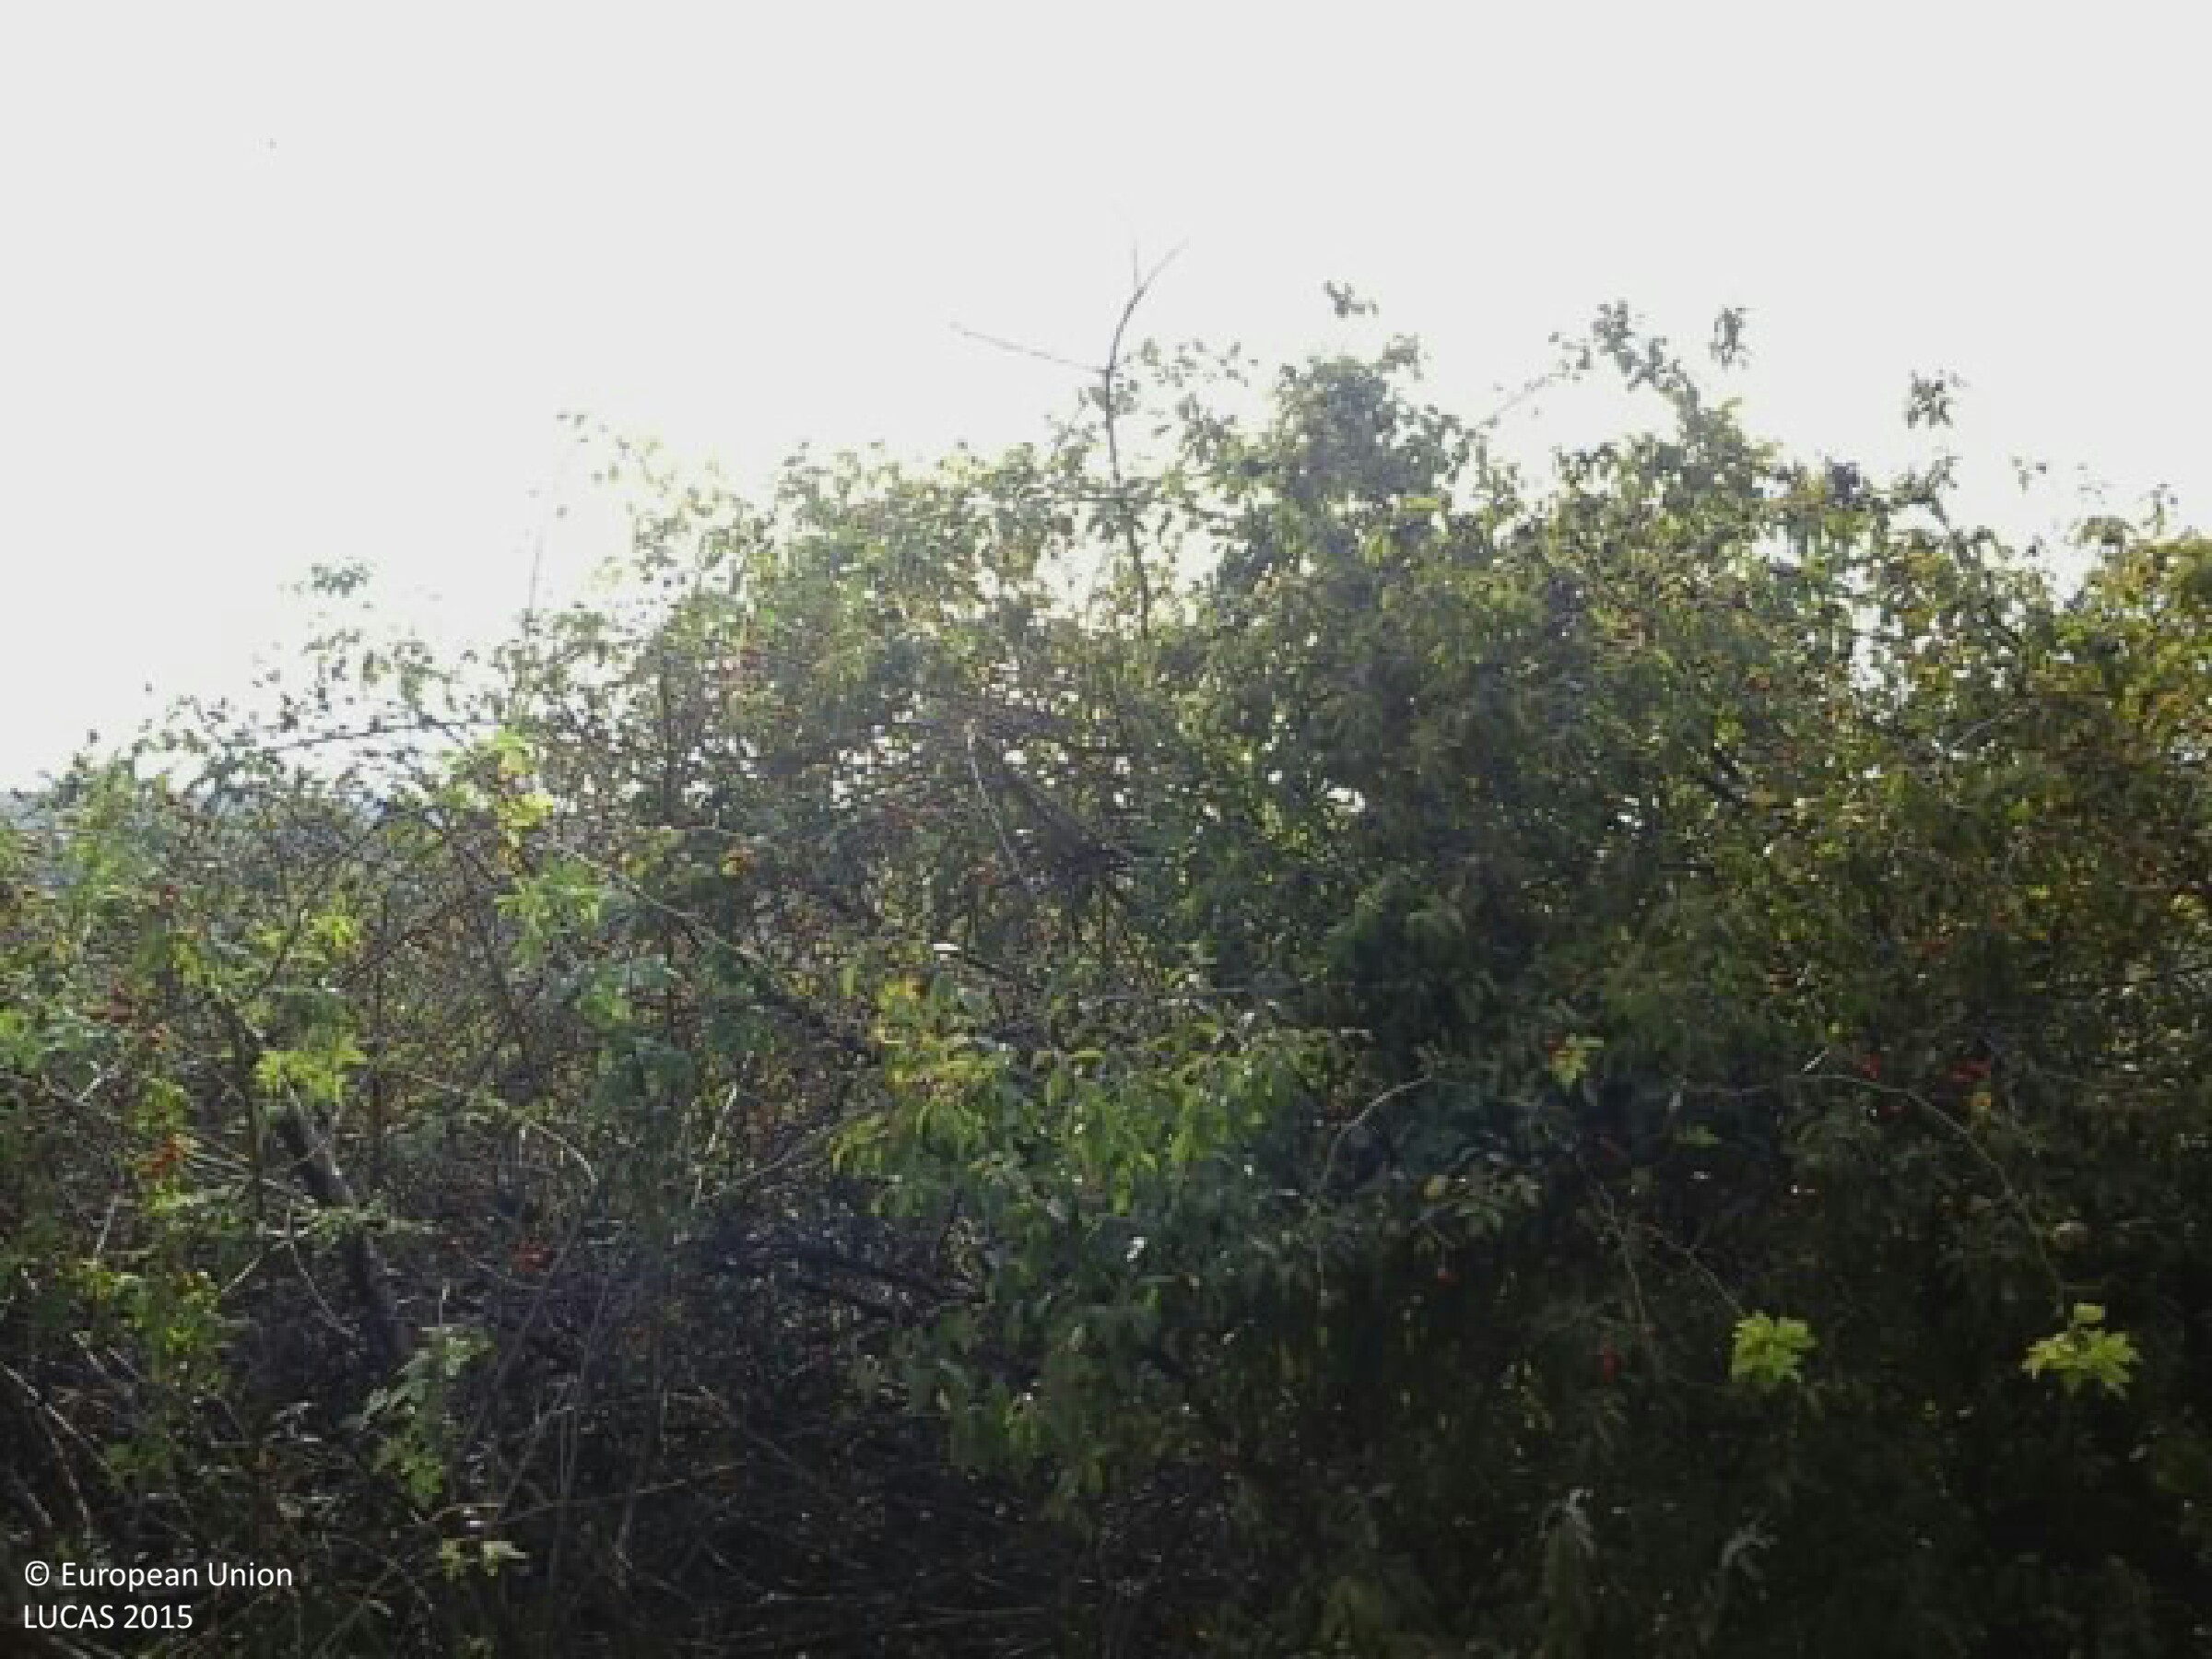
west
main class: Shrubland
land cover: Shrubland without tree cover
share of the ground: > 75 %
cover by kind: herbaceous plants 85 %, shrubs 15 %
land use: Agriculture (excluding fallow land and kitchen gardens)
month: September
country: HU
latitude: 47.7673
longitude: 19.8055
